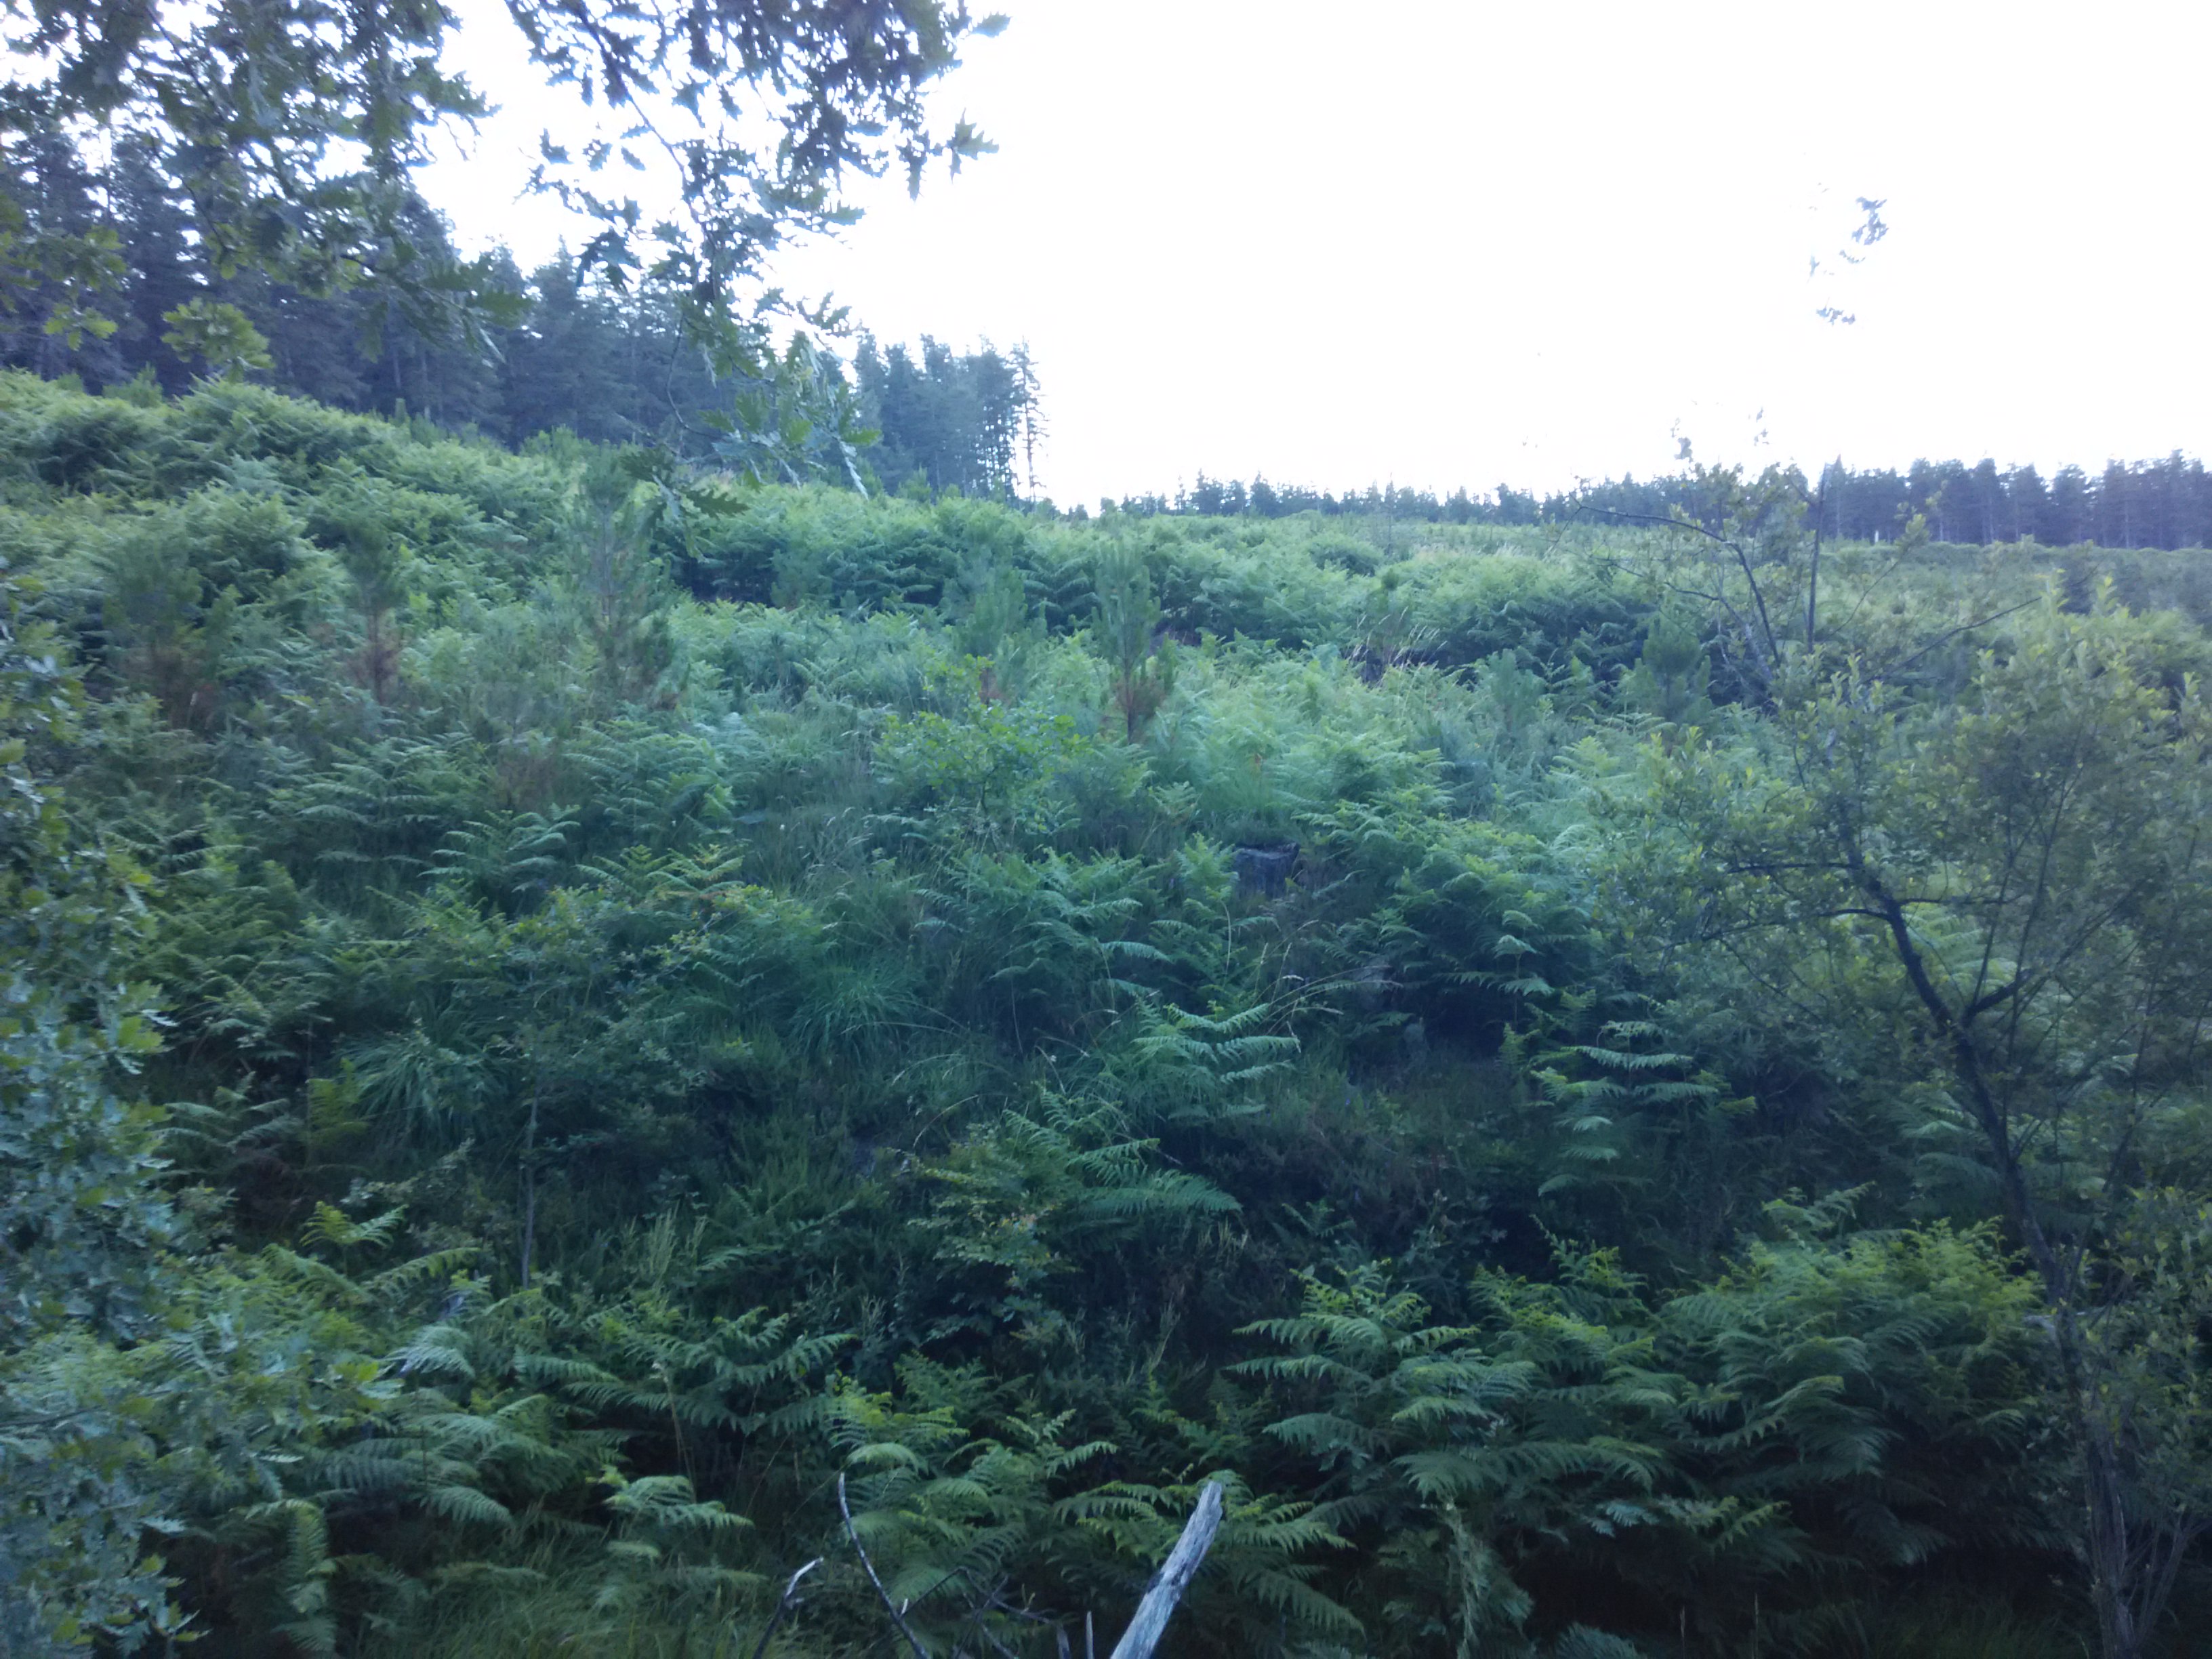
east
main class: Woodland
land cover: Pine dominated coniferous woodland
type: exotic forest
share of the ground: > 75 %
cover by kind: coniferous forest trees 100 %
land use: Forestry
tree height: < 5 m
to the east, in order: Pine dominated coniferous woodland; Fences; Pine dominated coniferous woodland; Rivers and streams; Pine dominated coniferous woodland; Paved roads, cycling and walking lanes; Pine dominated coniferous woodland
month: July
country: ES
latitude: 43.2146
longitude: -2.5973
